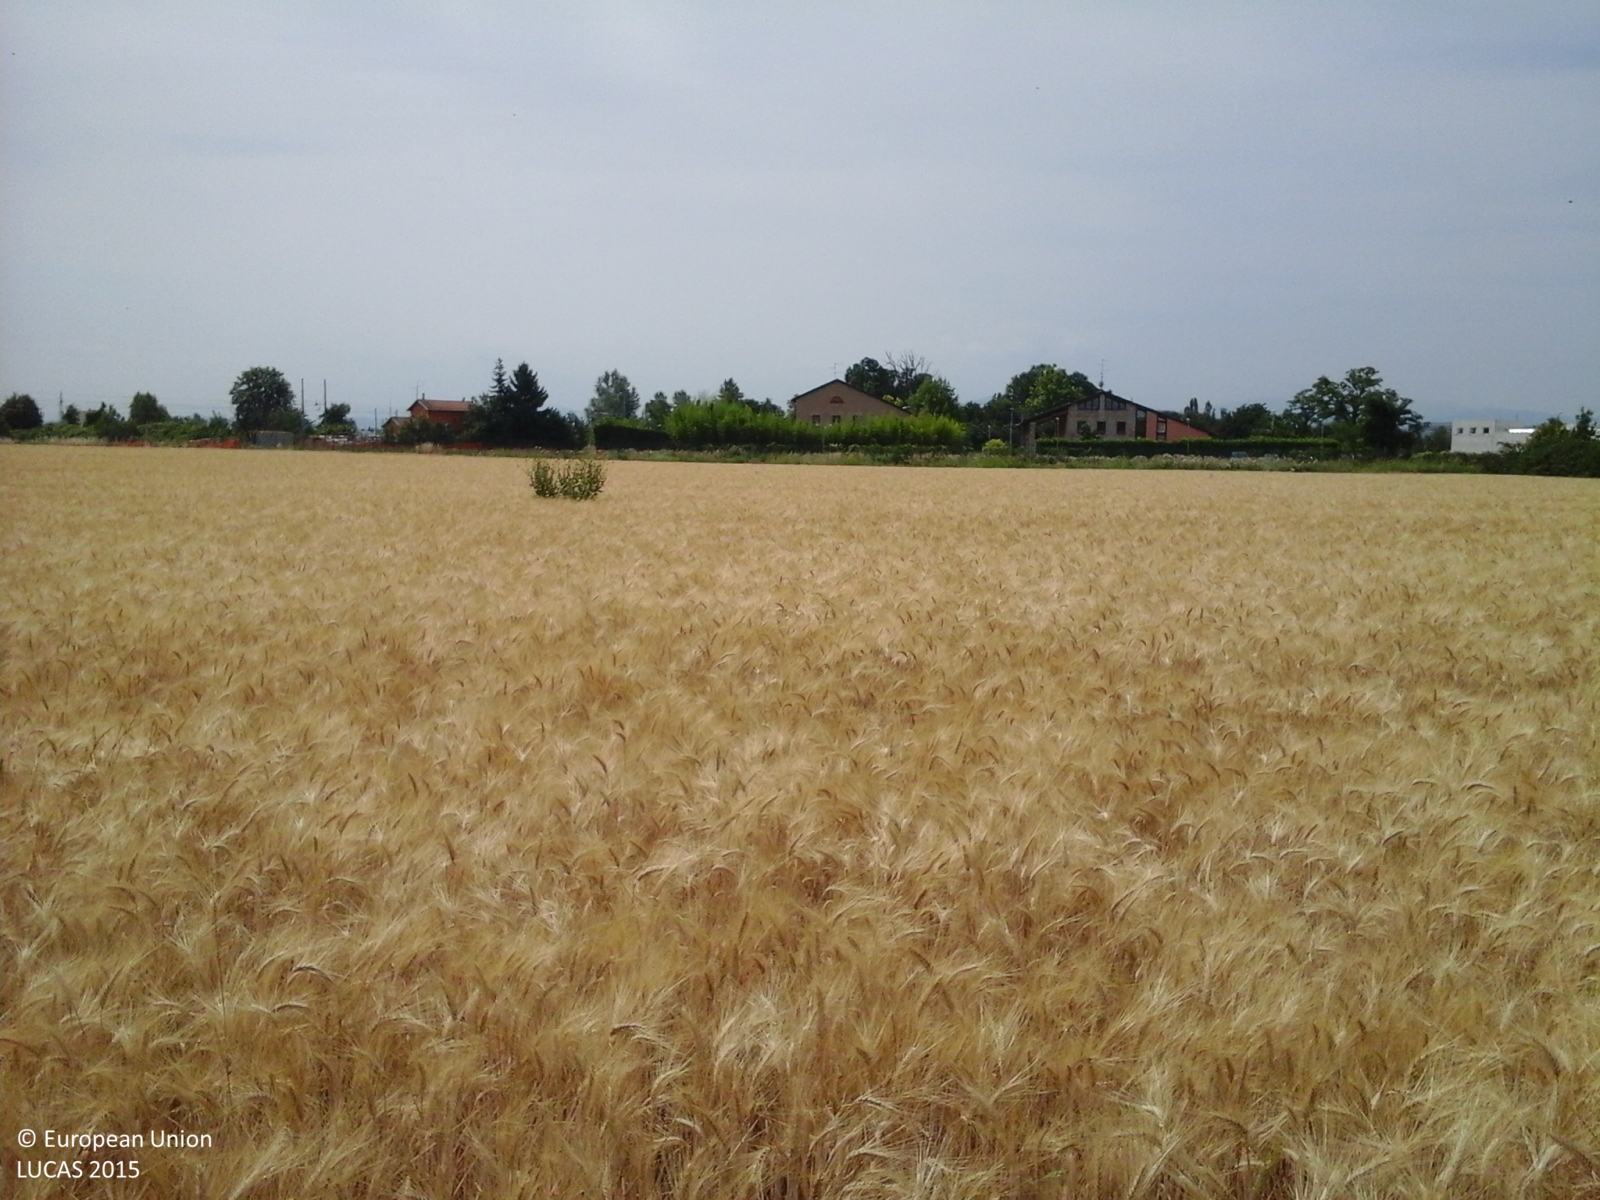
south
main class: Cropland
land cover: Common wheat
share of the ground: > 75 %
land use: Agriculture (excluding fallow land and kitchen gardens)
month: June
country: IT
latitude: 44.7830
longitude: 10.2648
